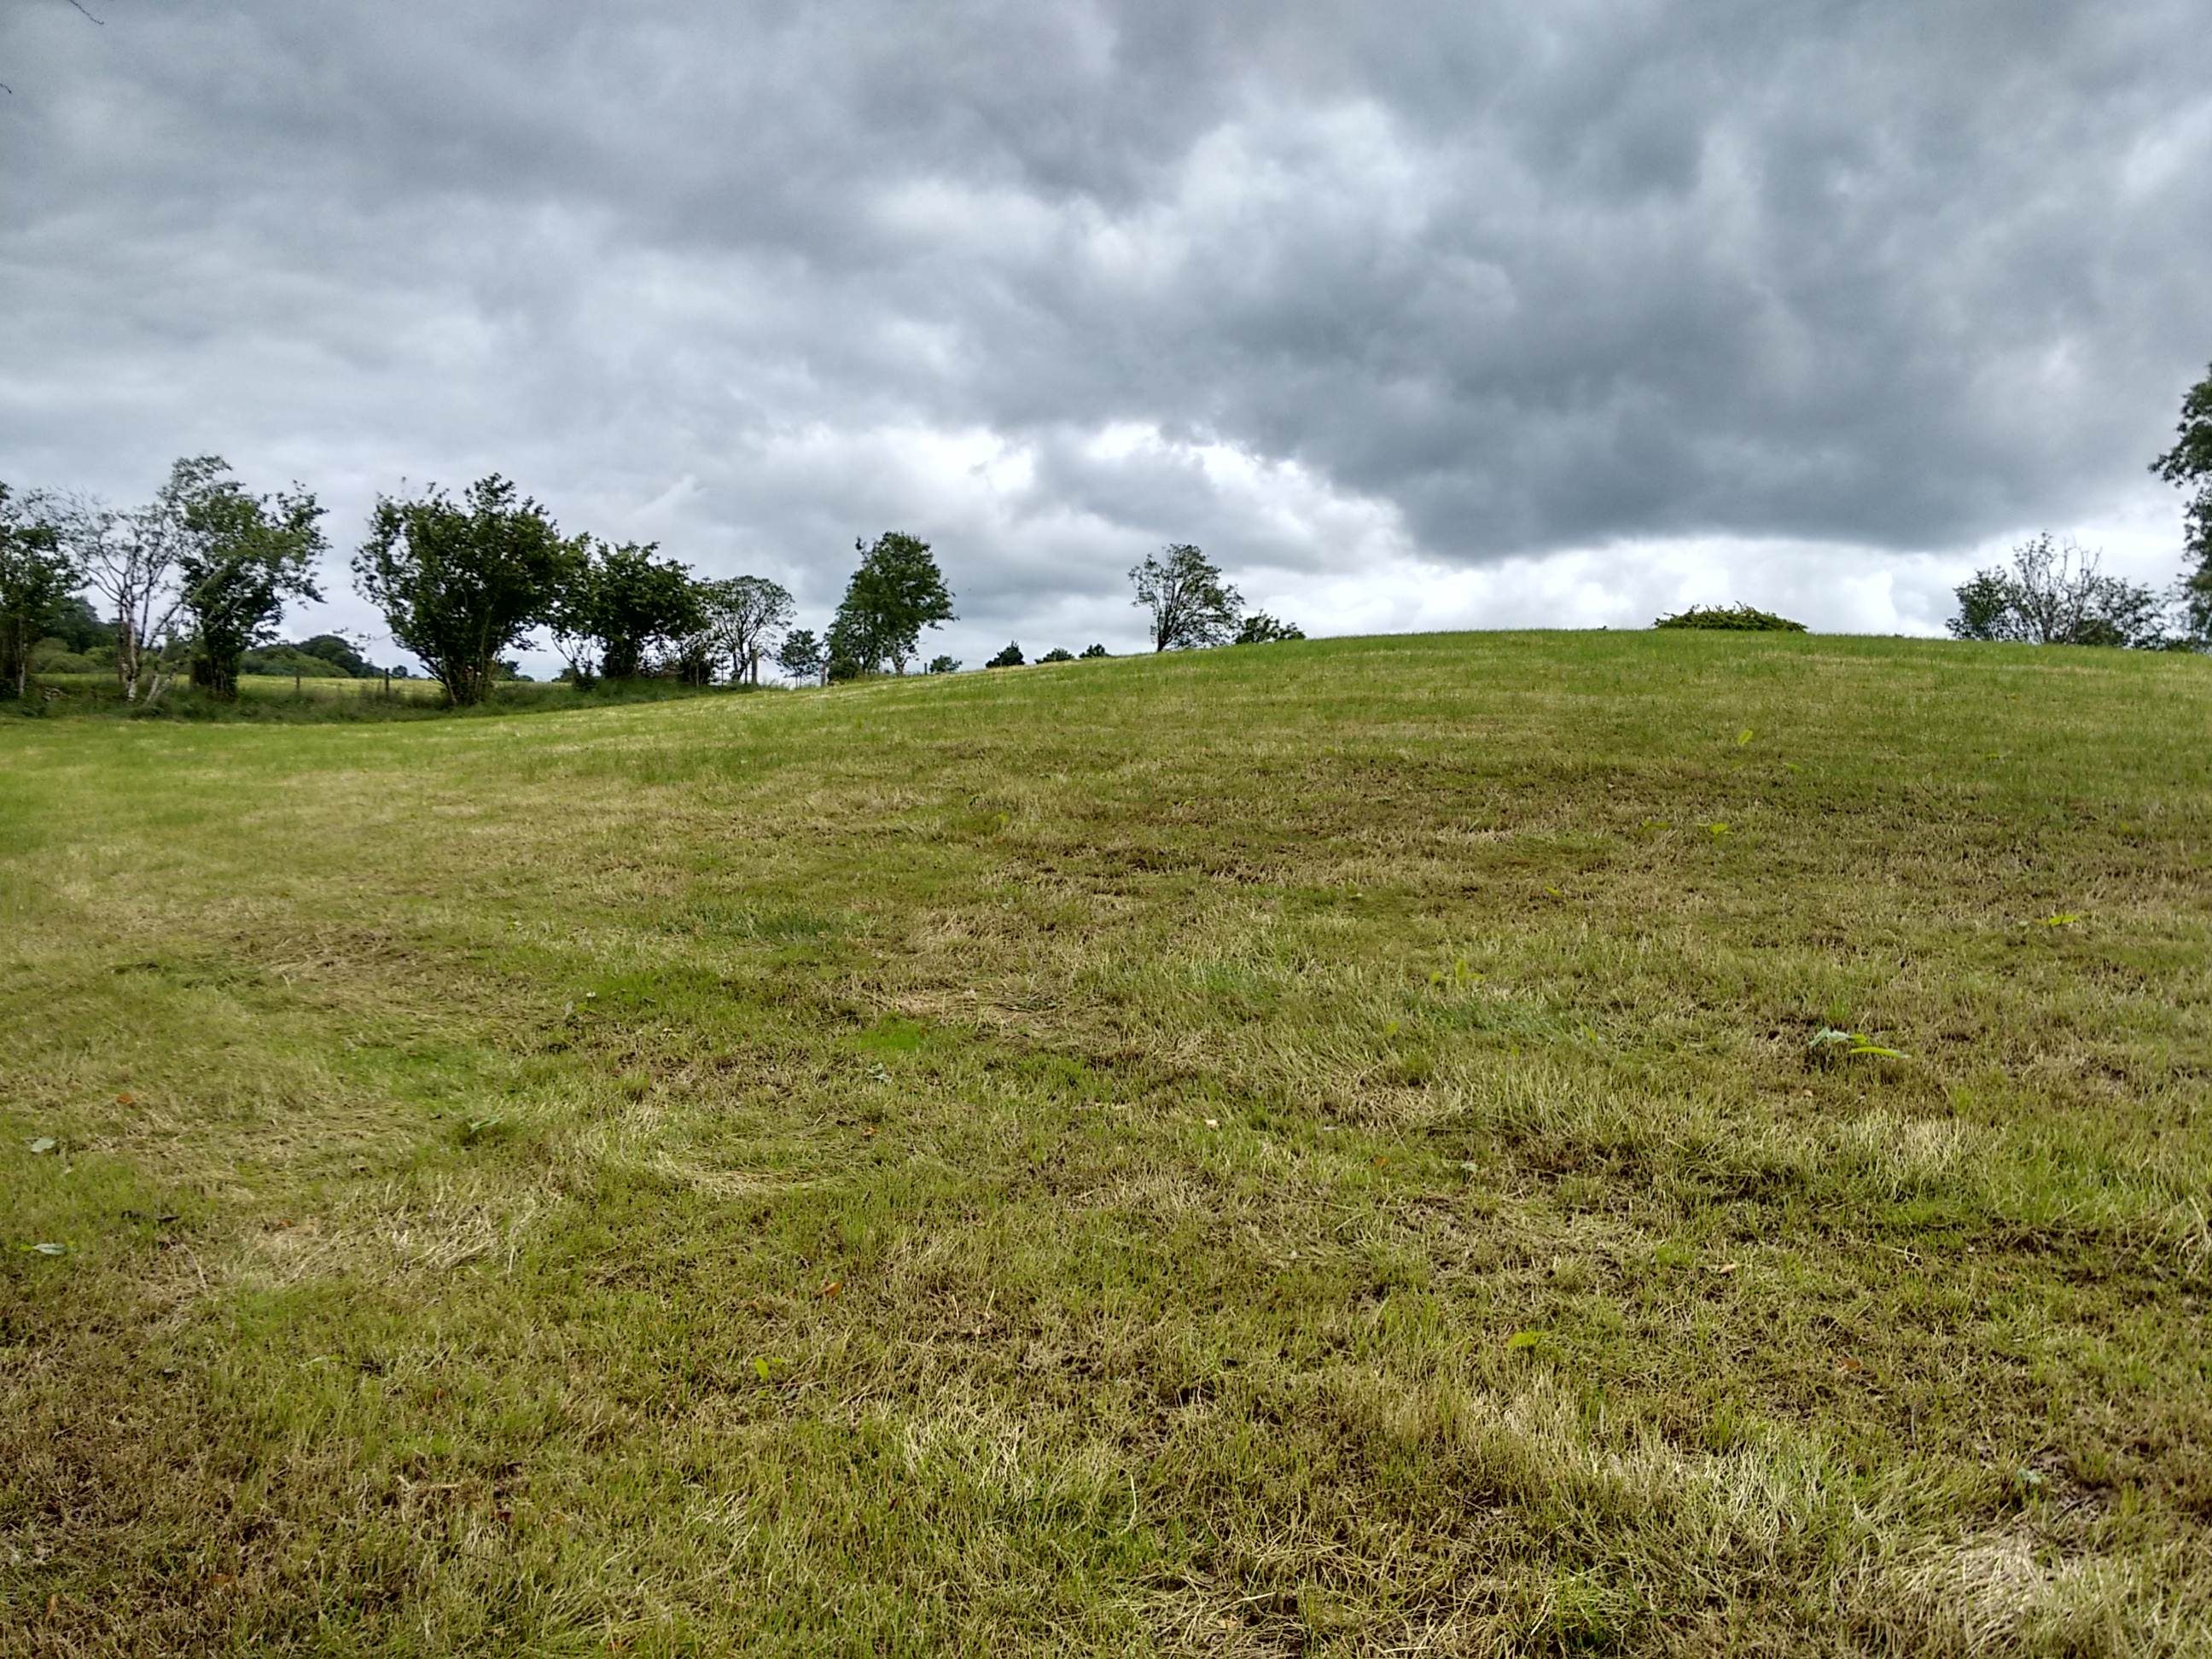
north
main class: Woodland
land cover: Broadleaved woodland
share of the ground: 25 - 50 %
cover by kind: herbaceous plants 50 %, broadleaved forest trees 40 %, shrubs 10 %
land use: Agriculture (excluding fallow land and kitchen gardens)
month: July
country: GB
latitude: 54.6762
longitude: -6.8363
